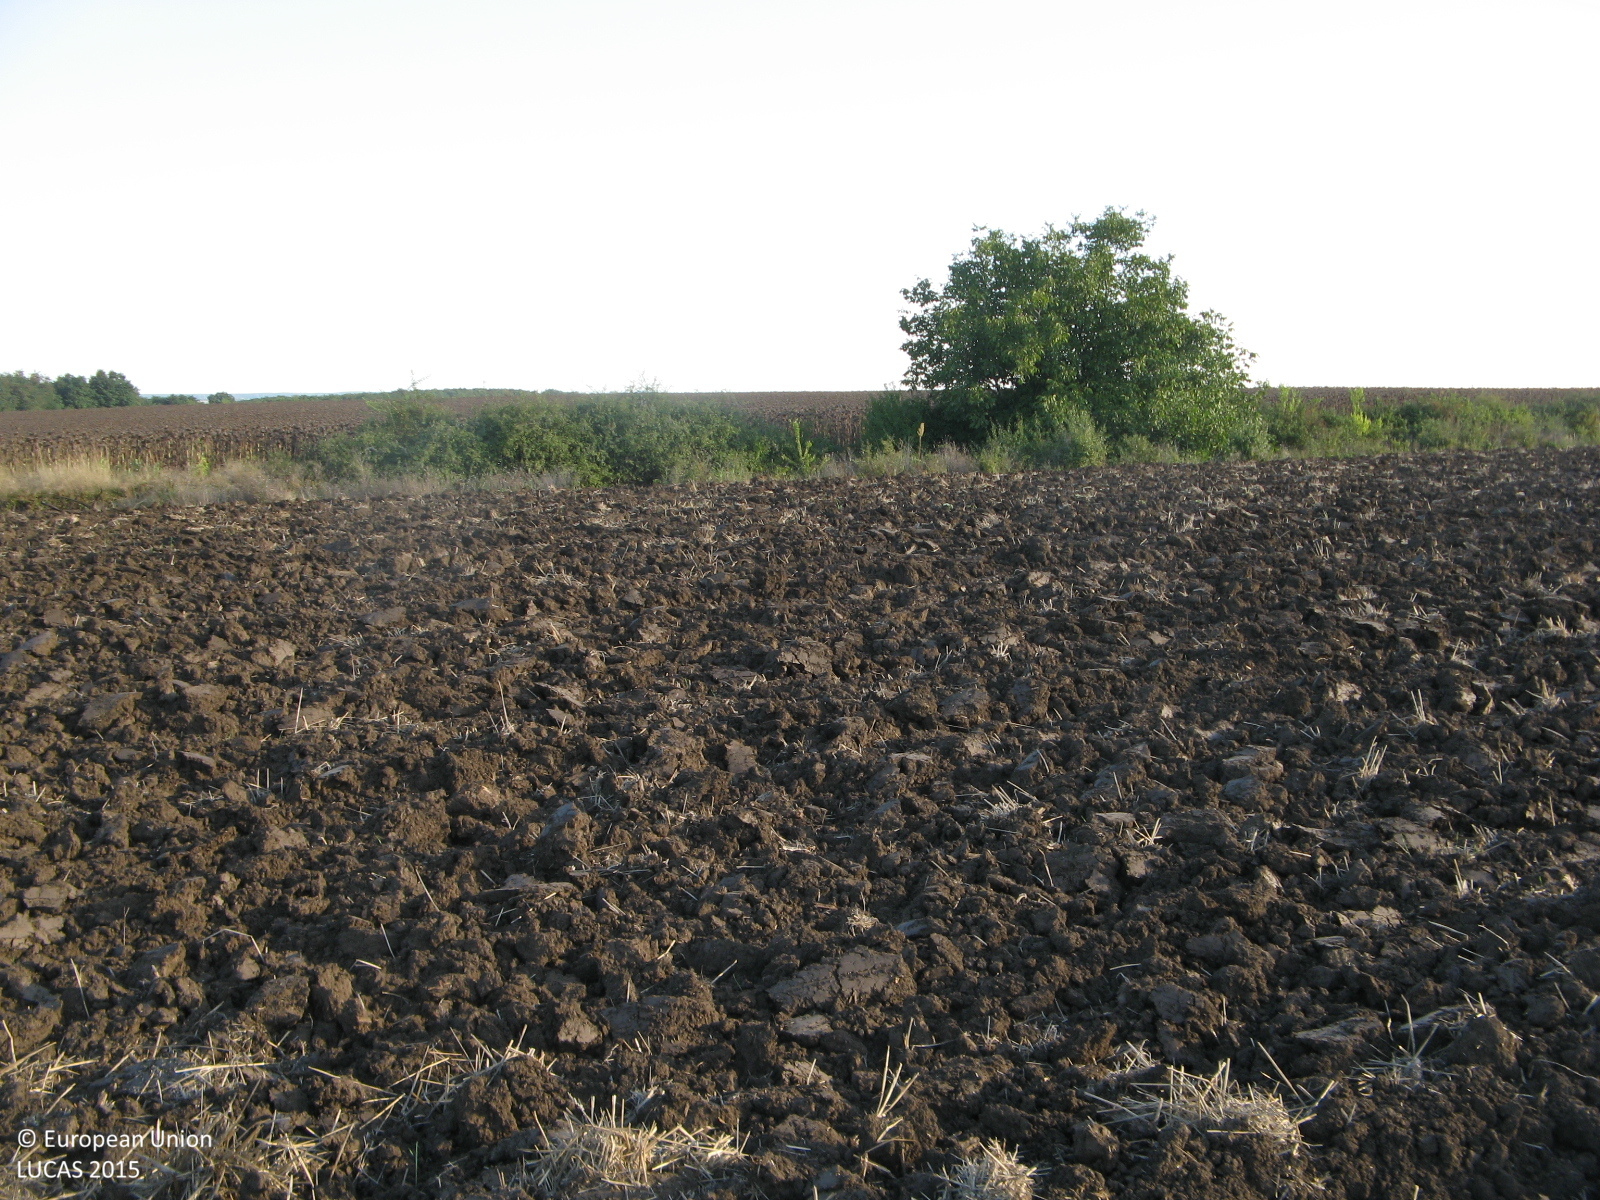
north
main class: Cropland
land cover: Common wheat
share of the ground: < 10 %
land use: Agriculture (excluding fallow land and kitchen gardens)
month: September
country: BG
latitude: 43.7614
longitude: 26.1091
